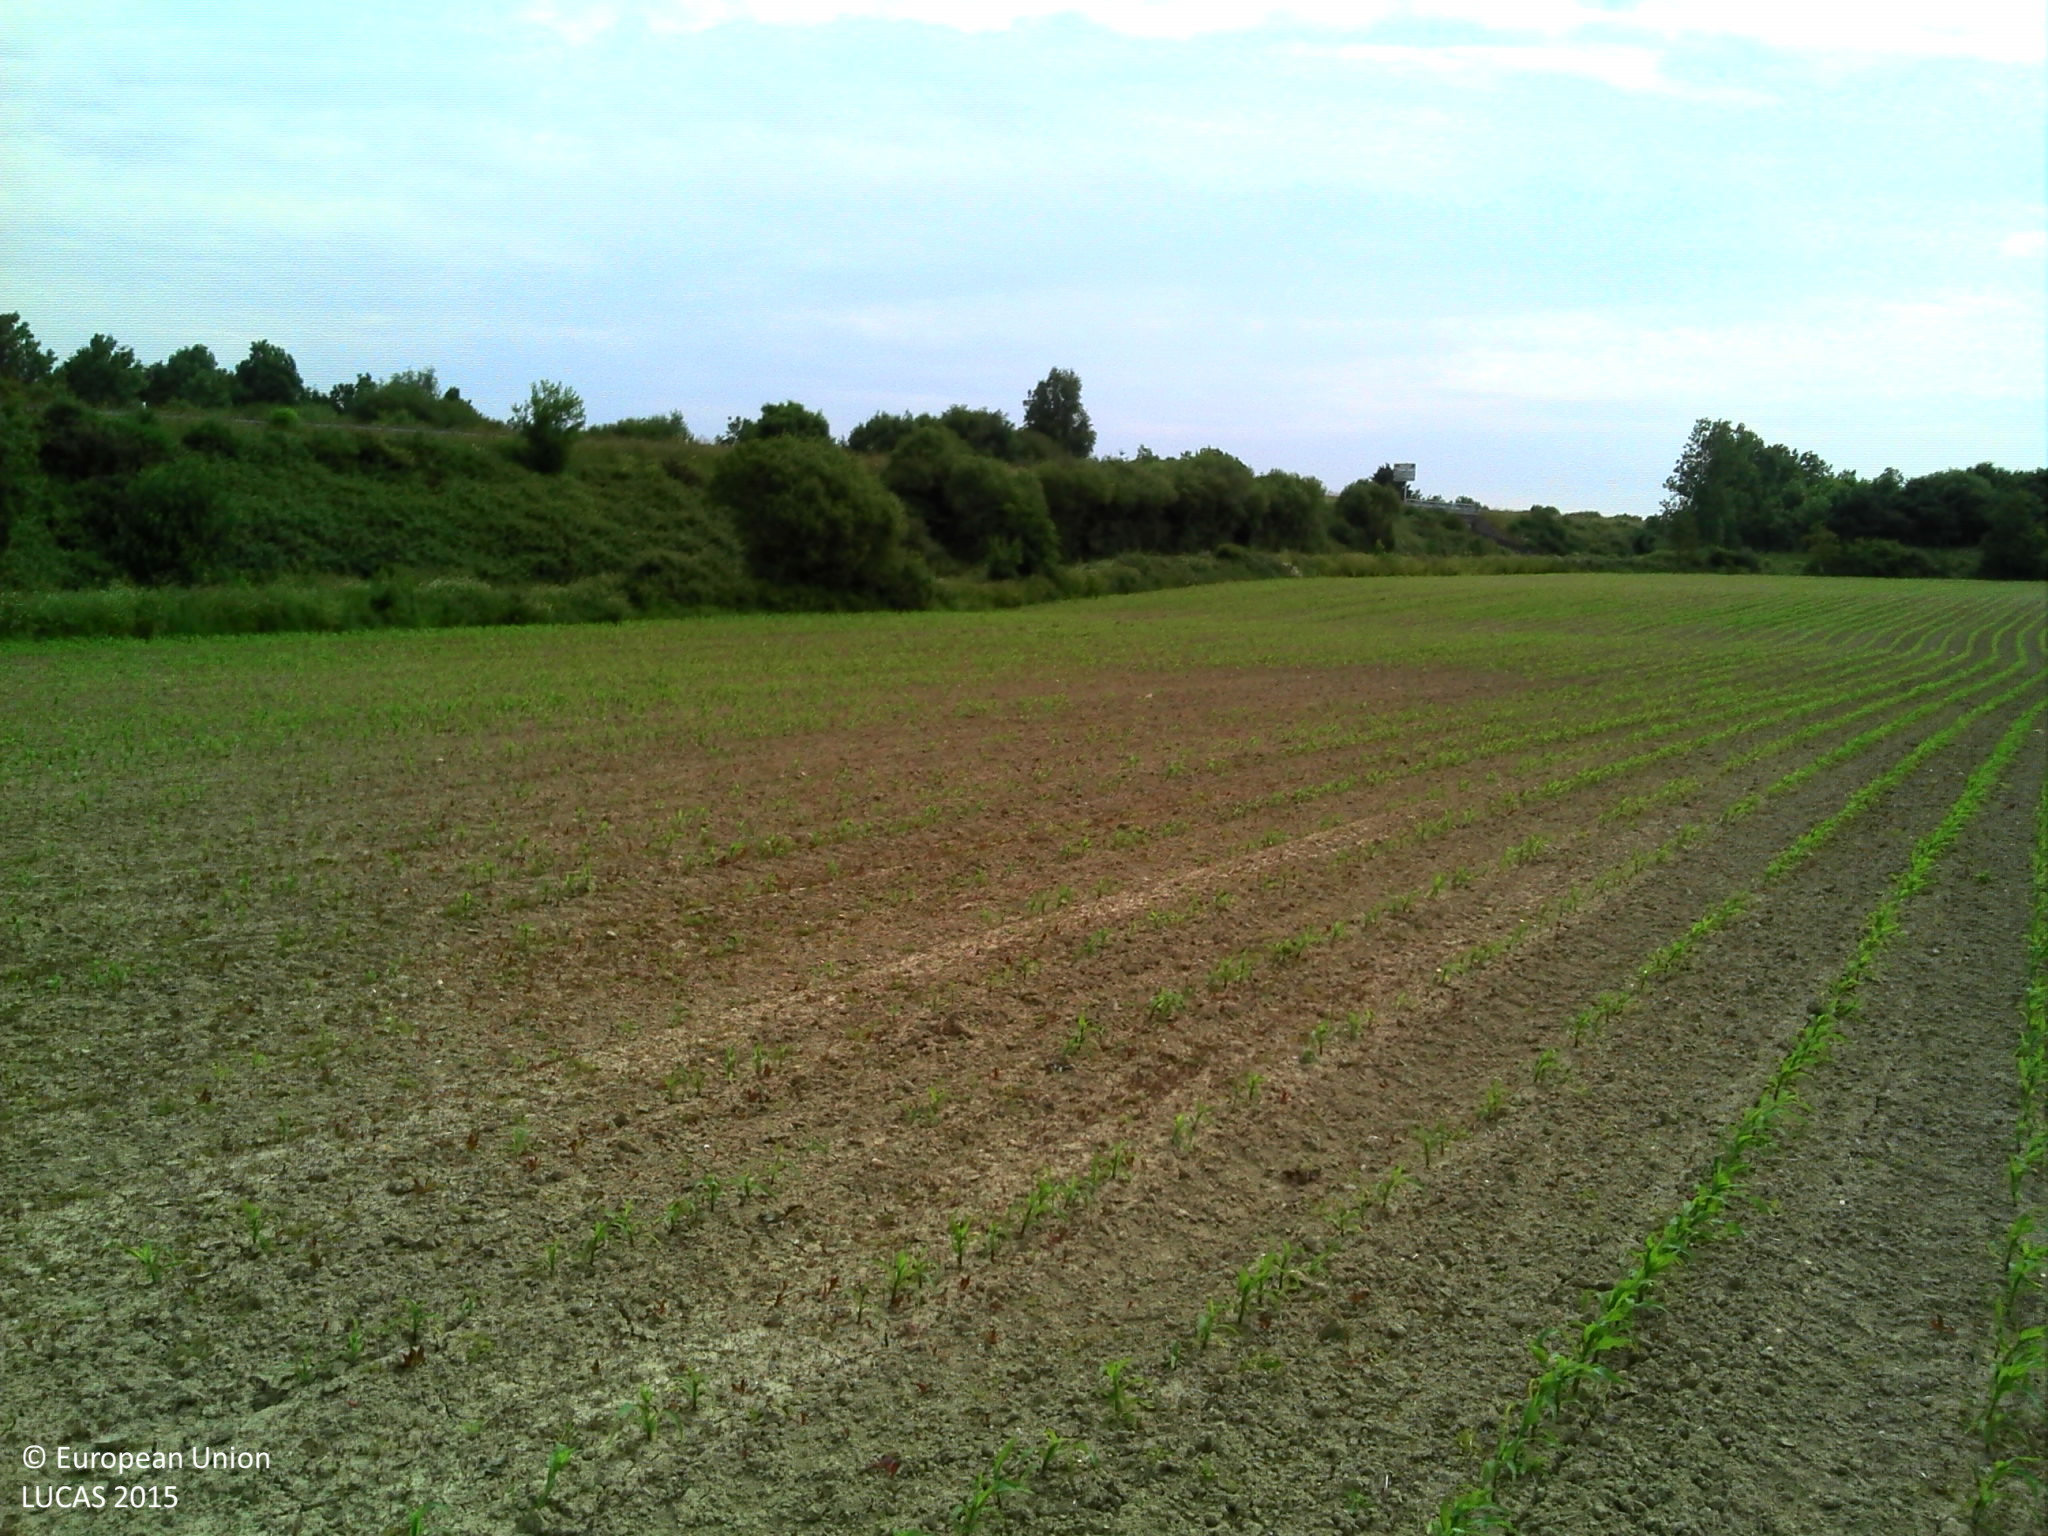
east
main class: Cropland
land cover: Maize
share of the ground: 10 - 25 %
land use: Agriculture (excluding fallow land and kitchen gardens)
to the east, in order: Maize; Abandoned hedges; Ditches and canals; Grass margins; Tracks; Grass margins; Ditches and canals; Spontaneously vegetated surfaces; Paved roads, cycling and walking lanes; Spontaneously vegetated surfaces
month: June
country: FR
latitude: 47.1047
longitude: -2.0524
